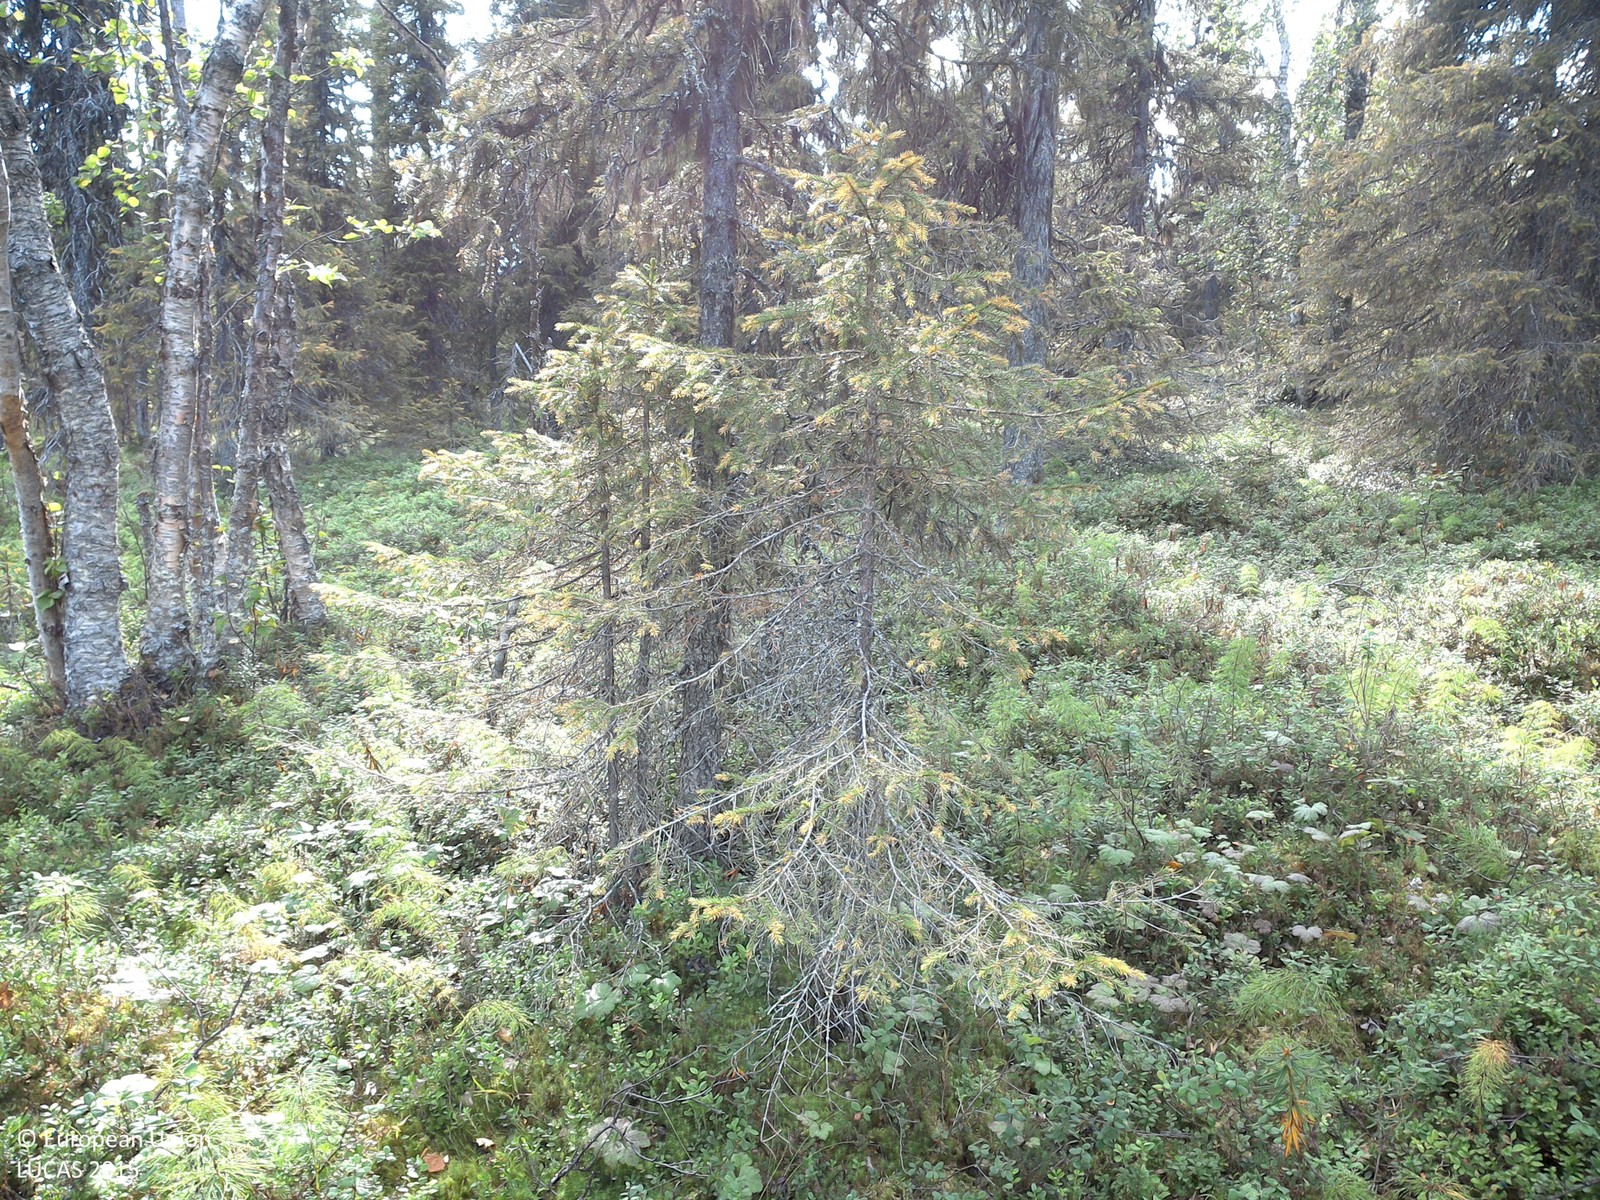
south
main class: Woodland
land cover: Spruce dominated coniferous woodland
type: boreal forest
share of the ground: 25 - 50 %
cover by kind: shrubs 40 %, coniferous forest trees 20 %, herbaceous plants 20 %, lichens and mosses 15 %, broadleaved forest trees 5 %
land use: Forestry
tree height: > 5 m
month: August
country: SE
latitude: 67.3180
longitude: 21.9699
